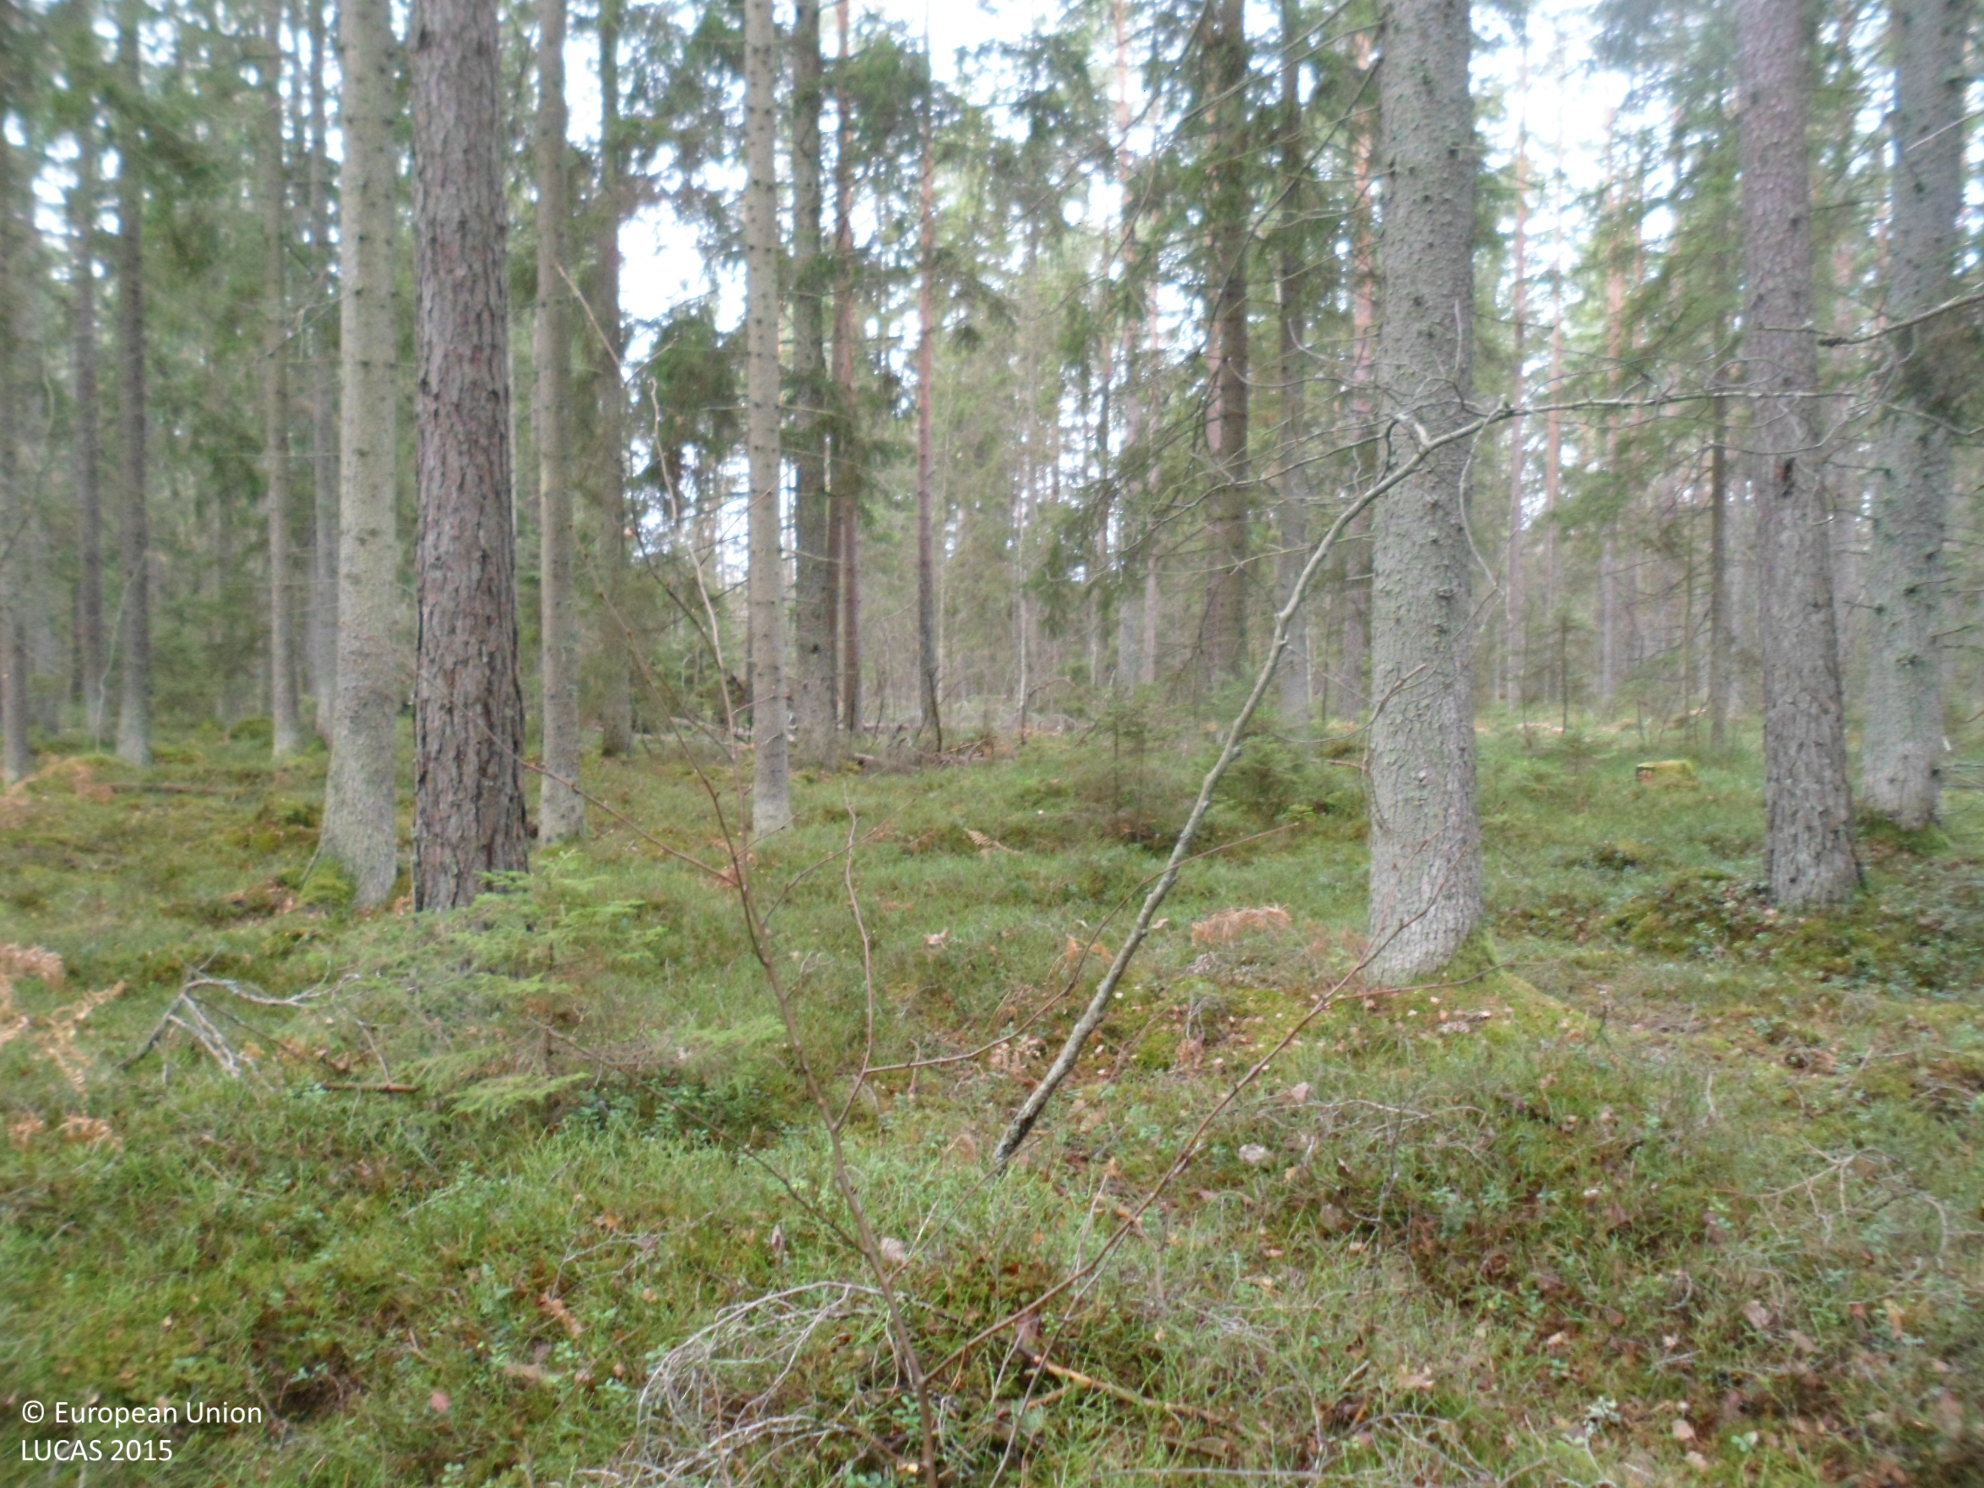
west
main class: Woodland
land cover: Spruce dominated coniferous woodland
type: boreal forest
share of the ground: 50 - 75 %
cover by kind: coniferous forest trees 60 %, lichens and mosses 20 %, shrubs 15 %, broadleaved forest trees 5 %
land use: Forestry
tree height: > 5 m
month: November
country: SE
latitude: 56.7566
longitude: 15.8711
